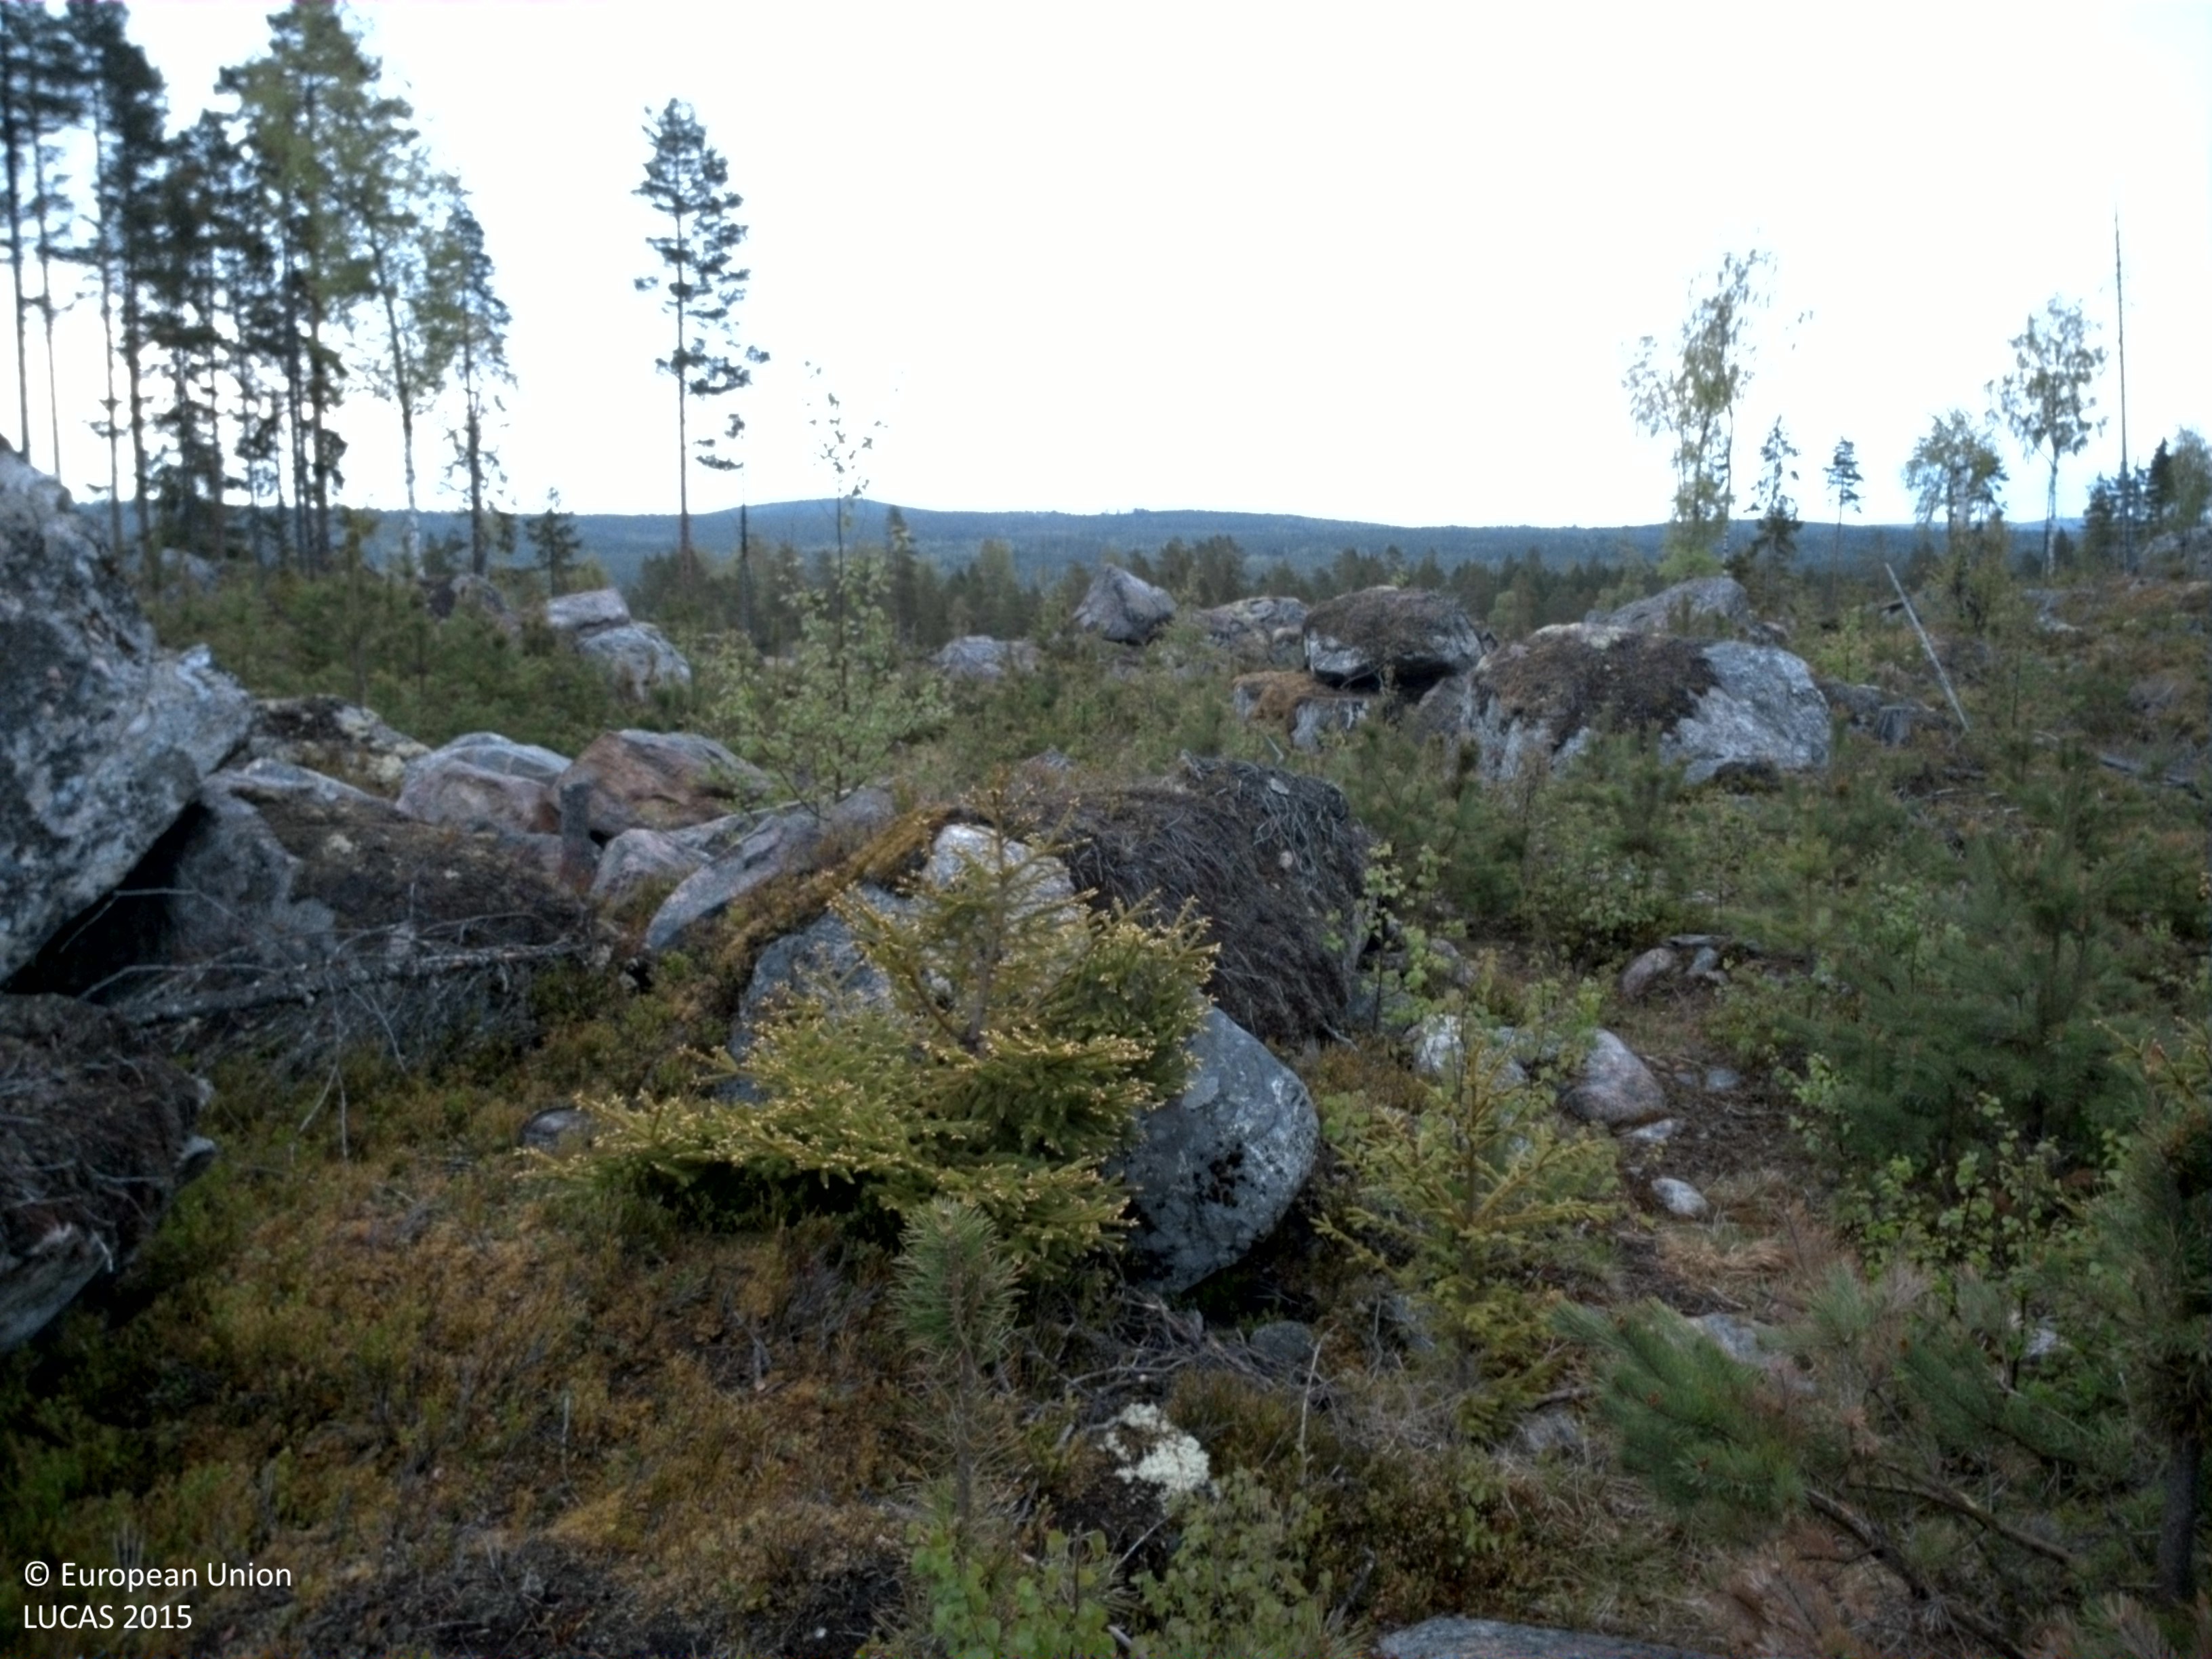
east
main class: Woodland
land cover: Pine dominated mixed woodland
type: boreal forest
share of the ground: 25 - 50 %
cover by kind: coniferous forest trees 30 %, shrubs 25 %, consolidated bare surface 20 %, broadleaved forest trees 15 %, lichens and mosses 10 %
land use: Forestry
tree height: < 5 m
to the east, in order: Pine dominated mixed woodland; Pine dominated coniferous woodland; Rocks and stones; Spruce dominated coniferous woodland; Pine dominated coniferous woodland; Rocks and stones; Pine dominated mixed woodland
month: September
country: SE
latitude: 61.1414
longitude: 15.4274
